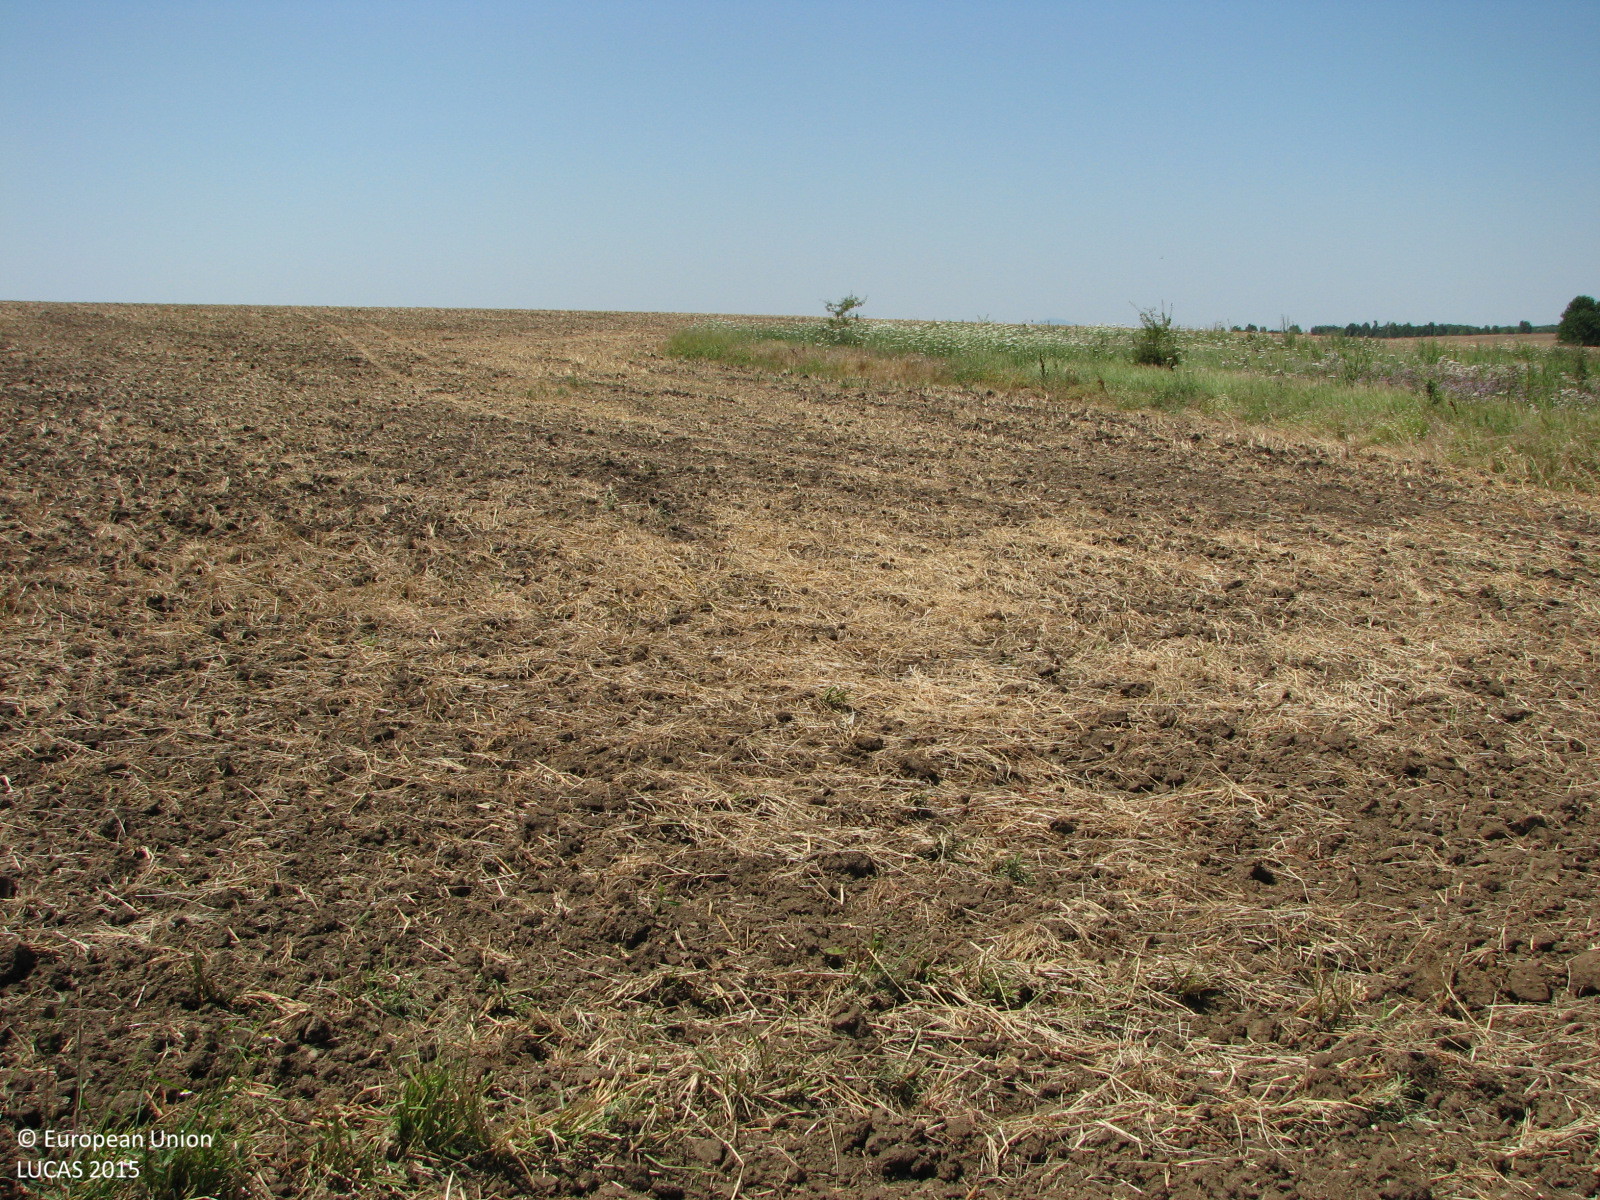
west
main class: Cropland
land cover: Common wheat
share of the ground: < 10 %
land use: Agriculture (excluding fallow land and kitchen gardens)
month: July
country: BG
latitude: 42.2240
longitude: 26.8528
